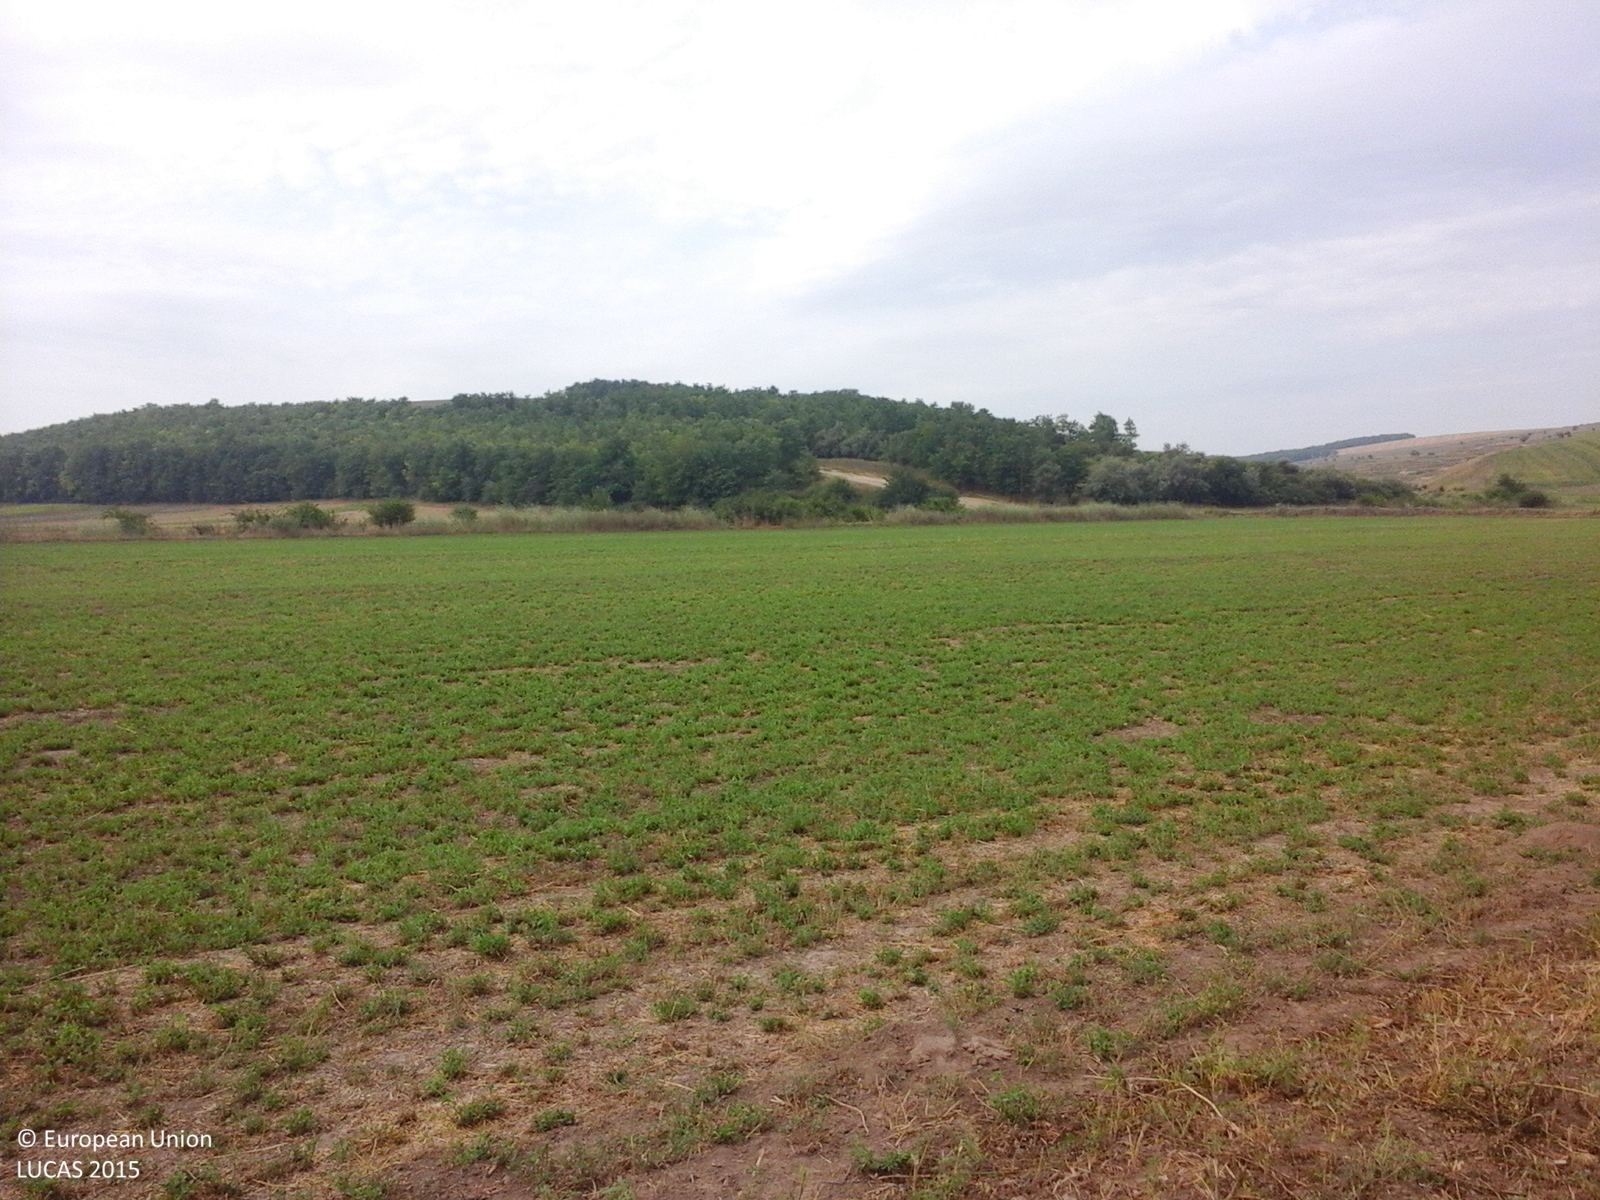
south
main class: Cropland
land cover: Lucerne
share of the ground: 10 - 25 %
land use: Agriculture (excluding fallow land and kitchen gardens)
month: August
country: RO
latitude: 44.1231
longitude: 27.9085
